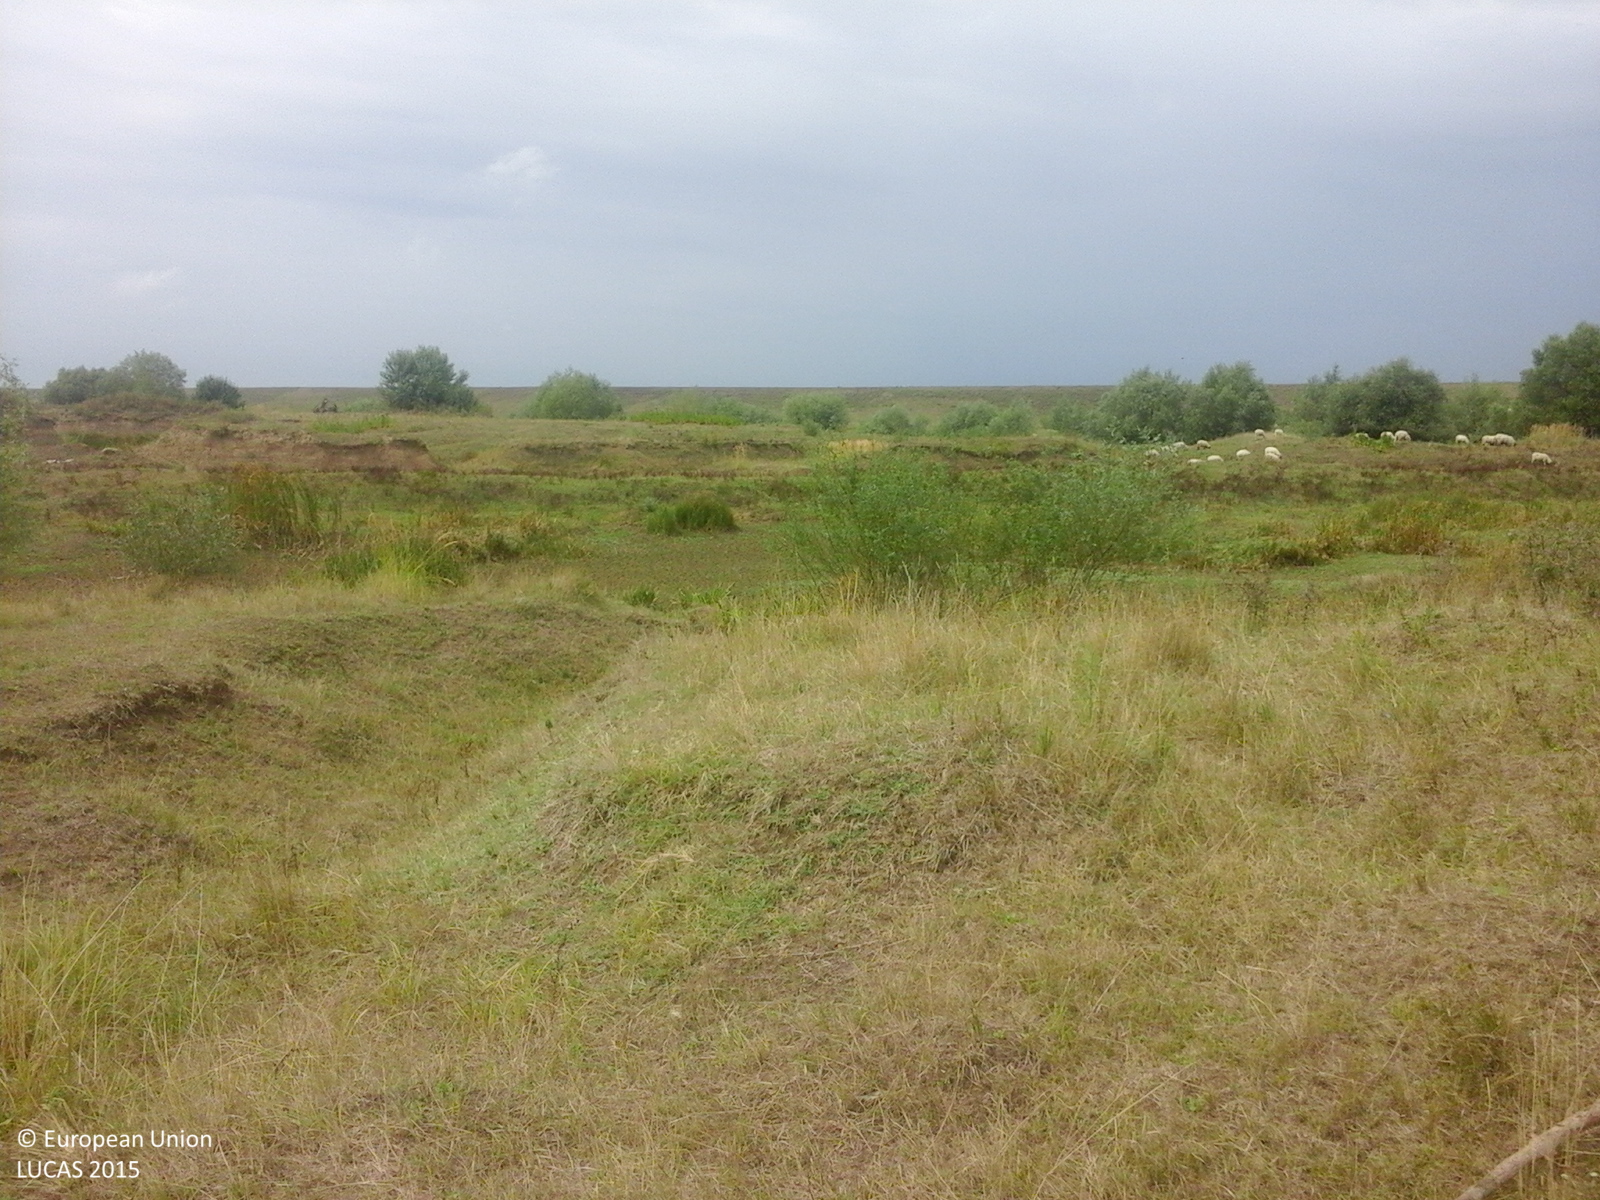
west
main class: Grassland
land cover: Grassland without tree/shrub cover
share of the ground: > 75 %
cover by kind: herbaceous plants 100 %
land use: Agriculture (excluding fallow land and kitchen gardens)
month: August
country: RO
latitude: 45.4743
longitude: 20.9889
